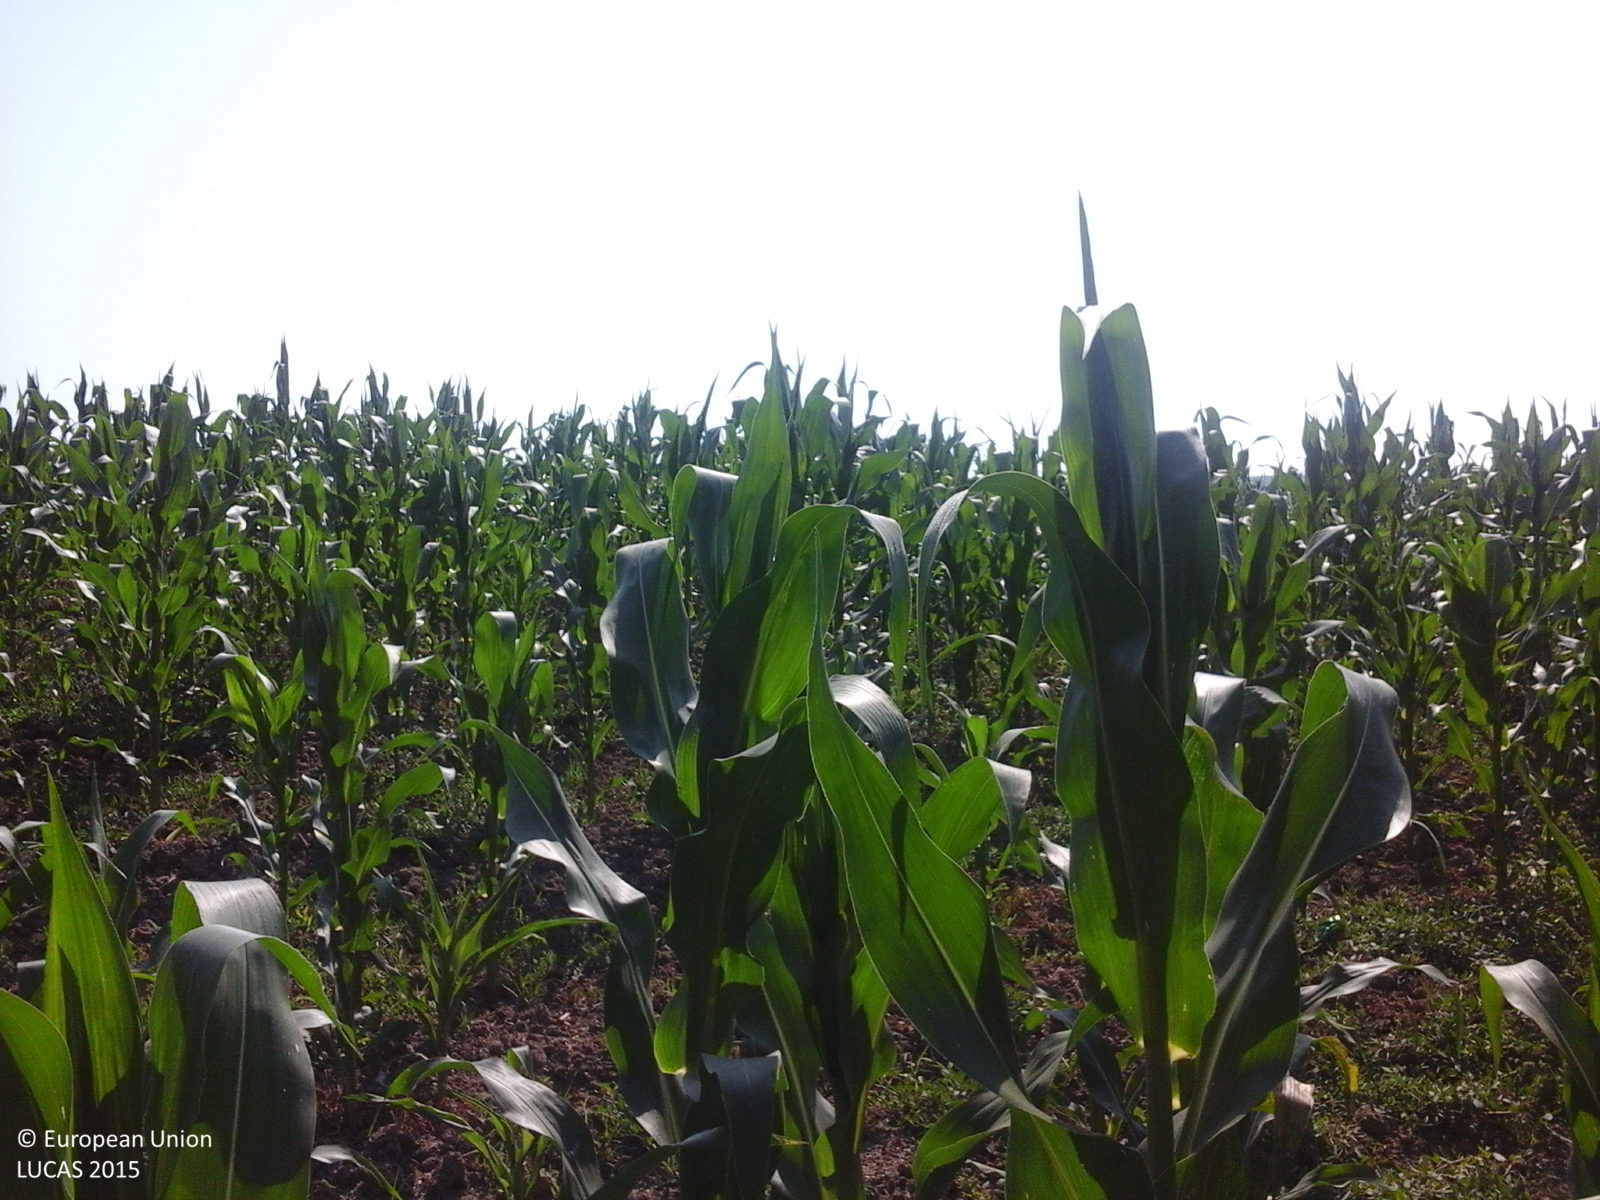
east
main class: Cropland
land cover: Maize
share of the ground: > 75 %
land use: Agriculture (excluding fallow land and kitchen gardens)
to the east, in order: Maize; Grass margins; Fences; Lines of trees; Maize; Lines of trees; Other fresh vegetables; Fences; Other fruit trees and berries; Permanent crops (only in case pi); Artificial constructions in urban areas
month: July
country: RO
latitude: 45.2030
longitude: 24.5532
